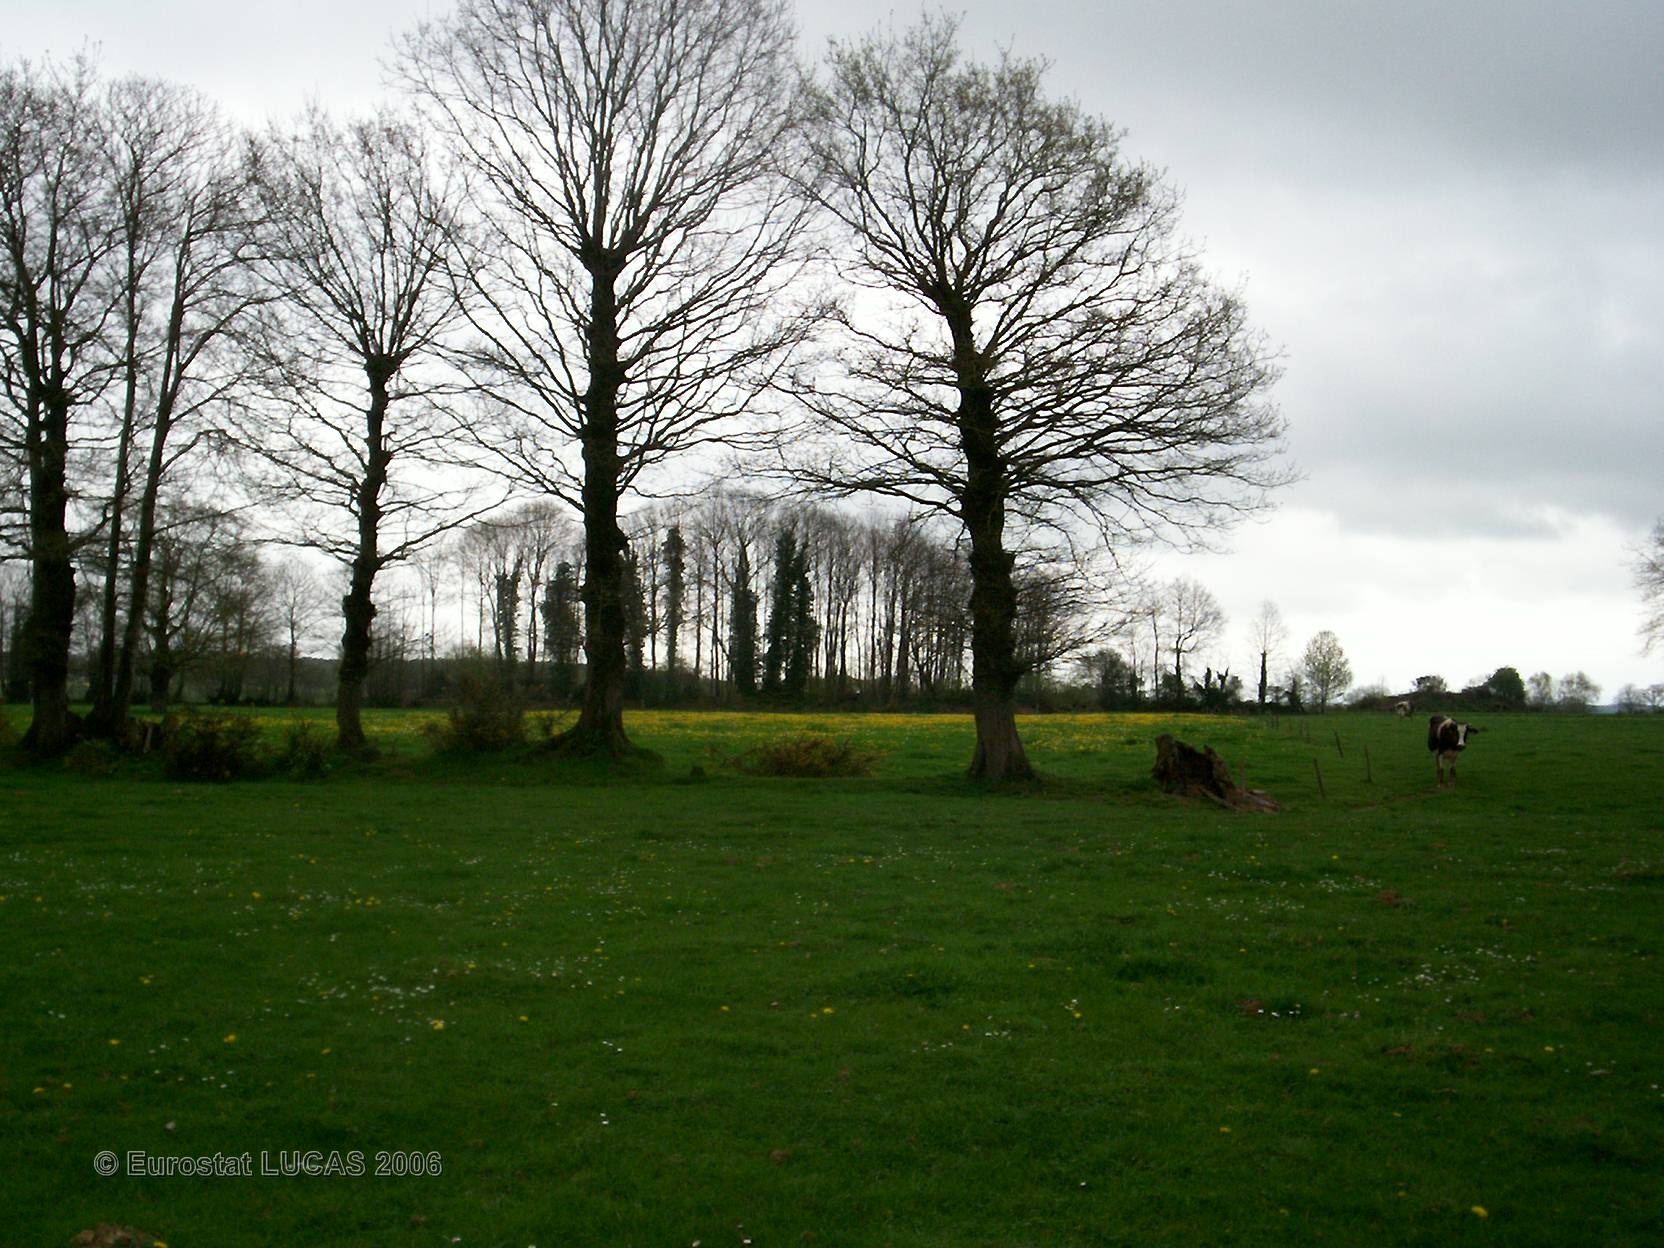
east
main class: Grassland
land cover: Grassland without tree/shrub cover
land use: Agriculture (excluding fallow land and kitchen gardens)
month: April
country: FR
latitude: 48.1175
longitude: -2.4309
